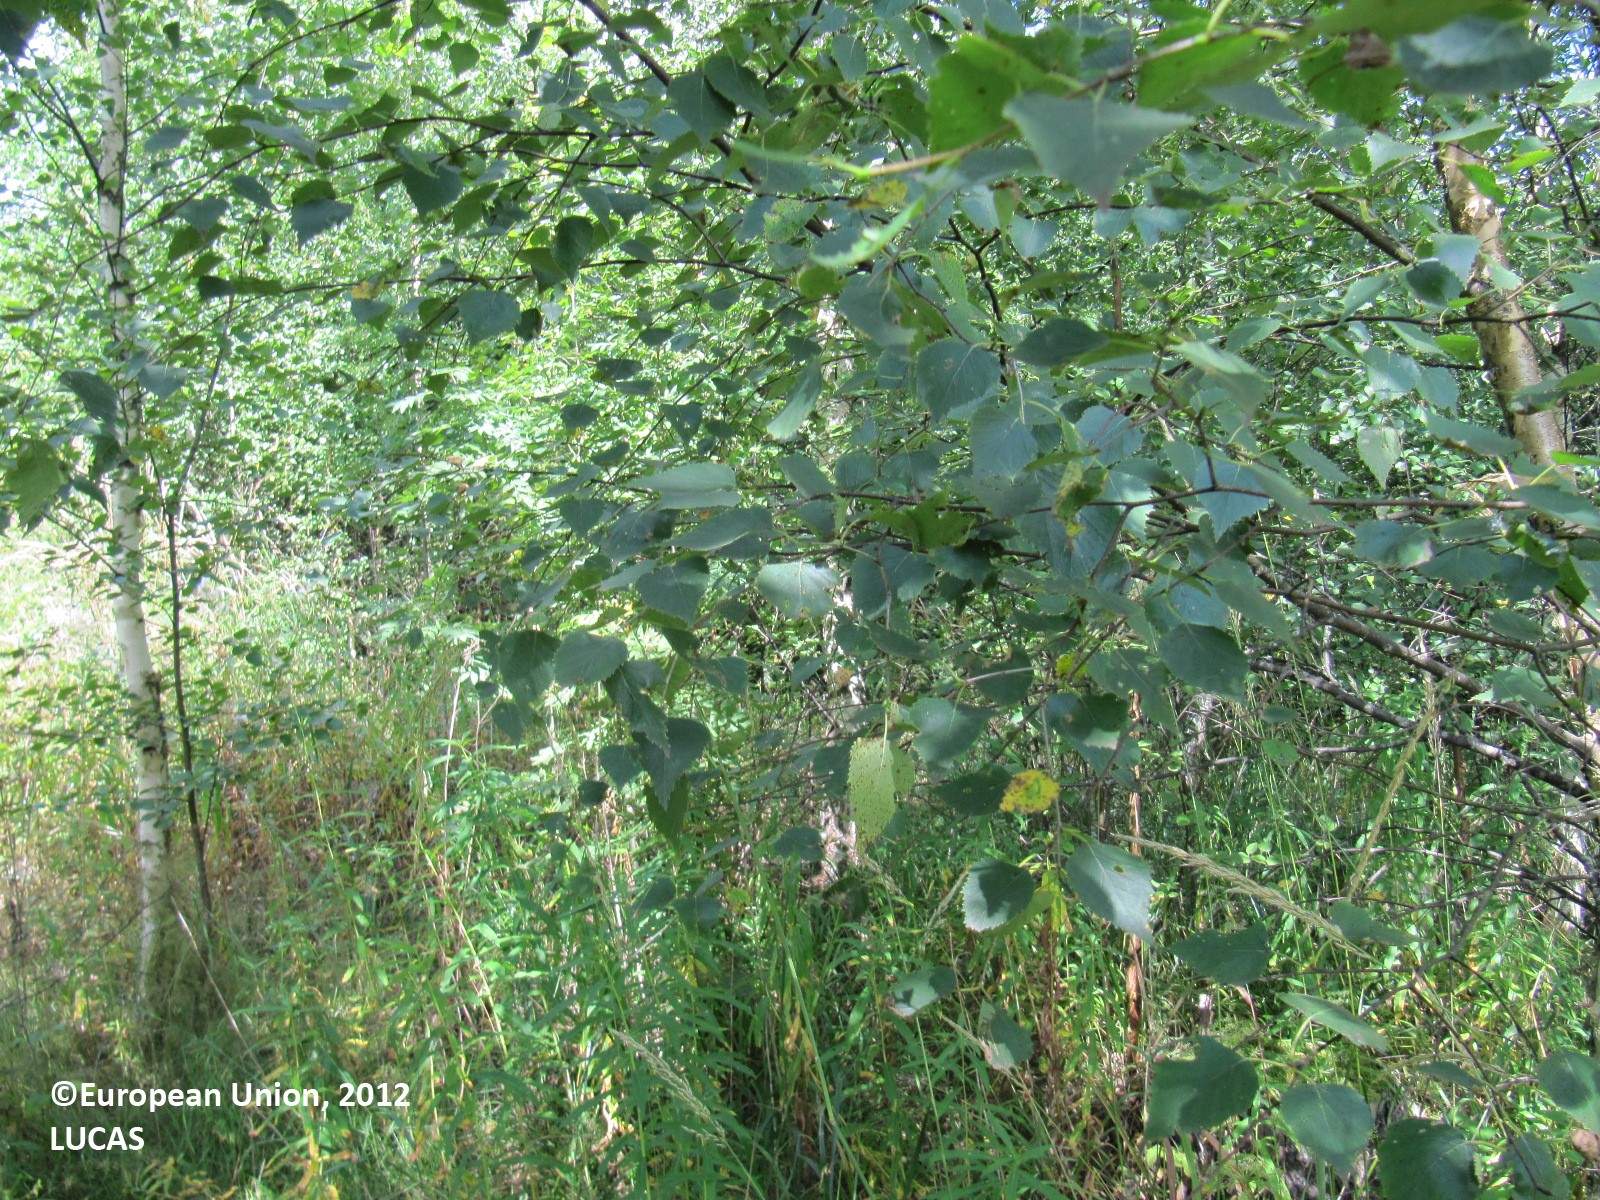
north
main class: Woodland
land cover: Broadleaved woodland
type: boreal forest
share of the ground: 50 - 75 %
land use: Forestry
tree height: > 5 m
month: August
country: FI
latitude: 60.4373
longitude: 24.4791
